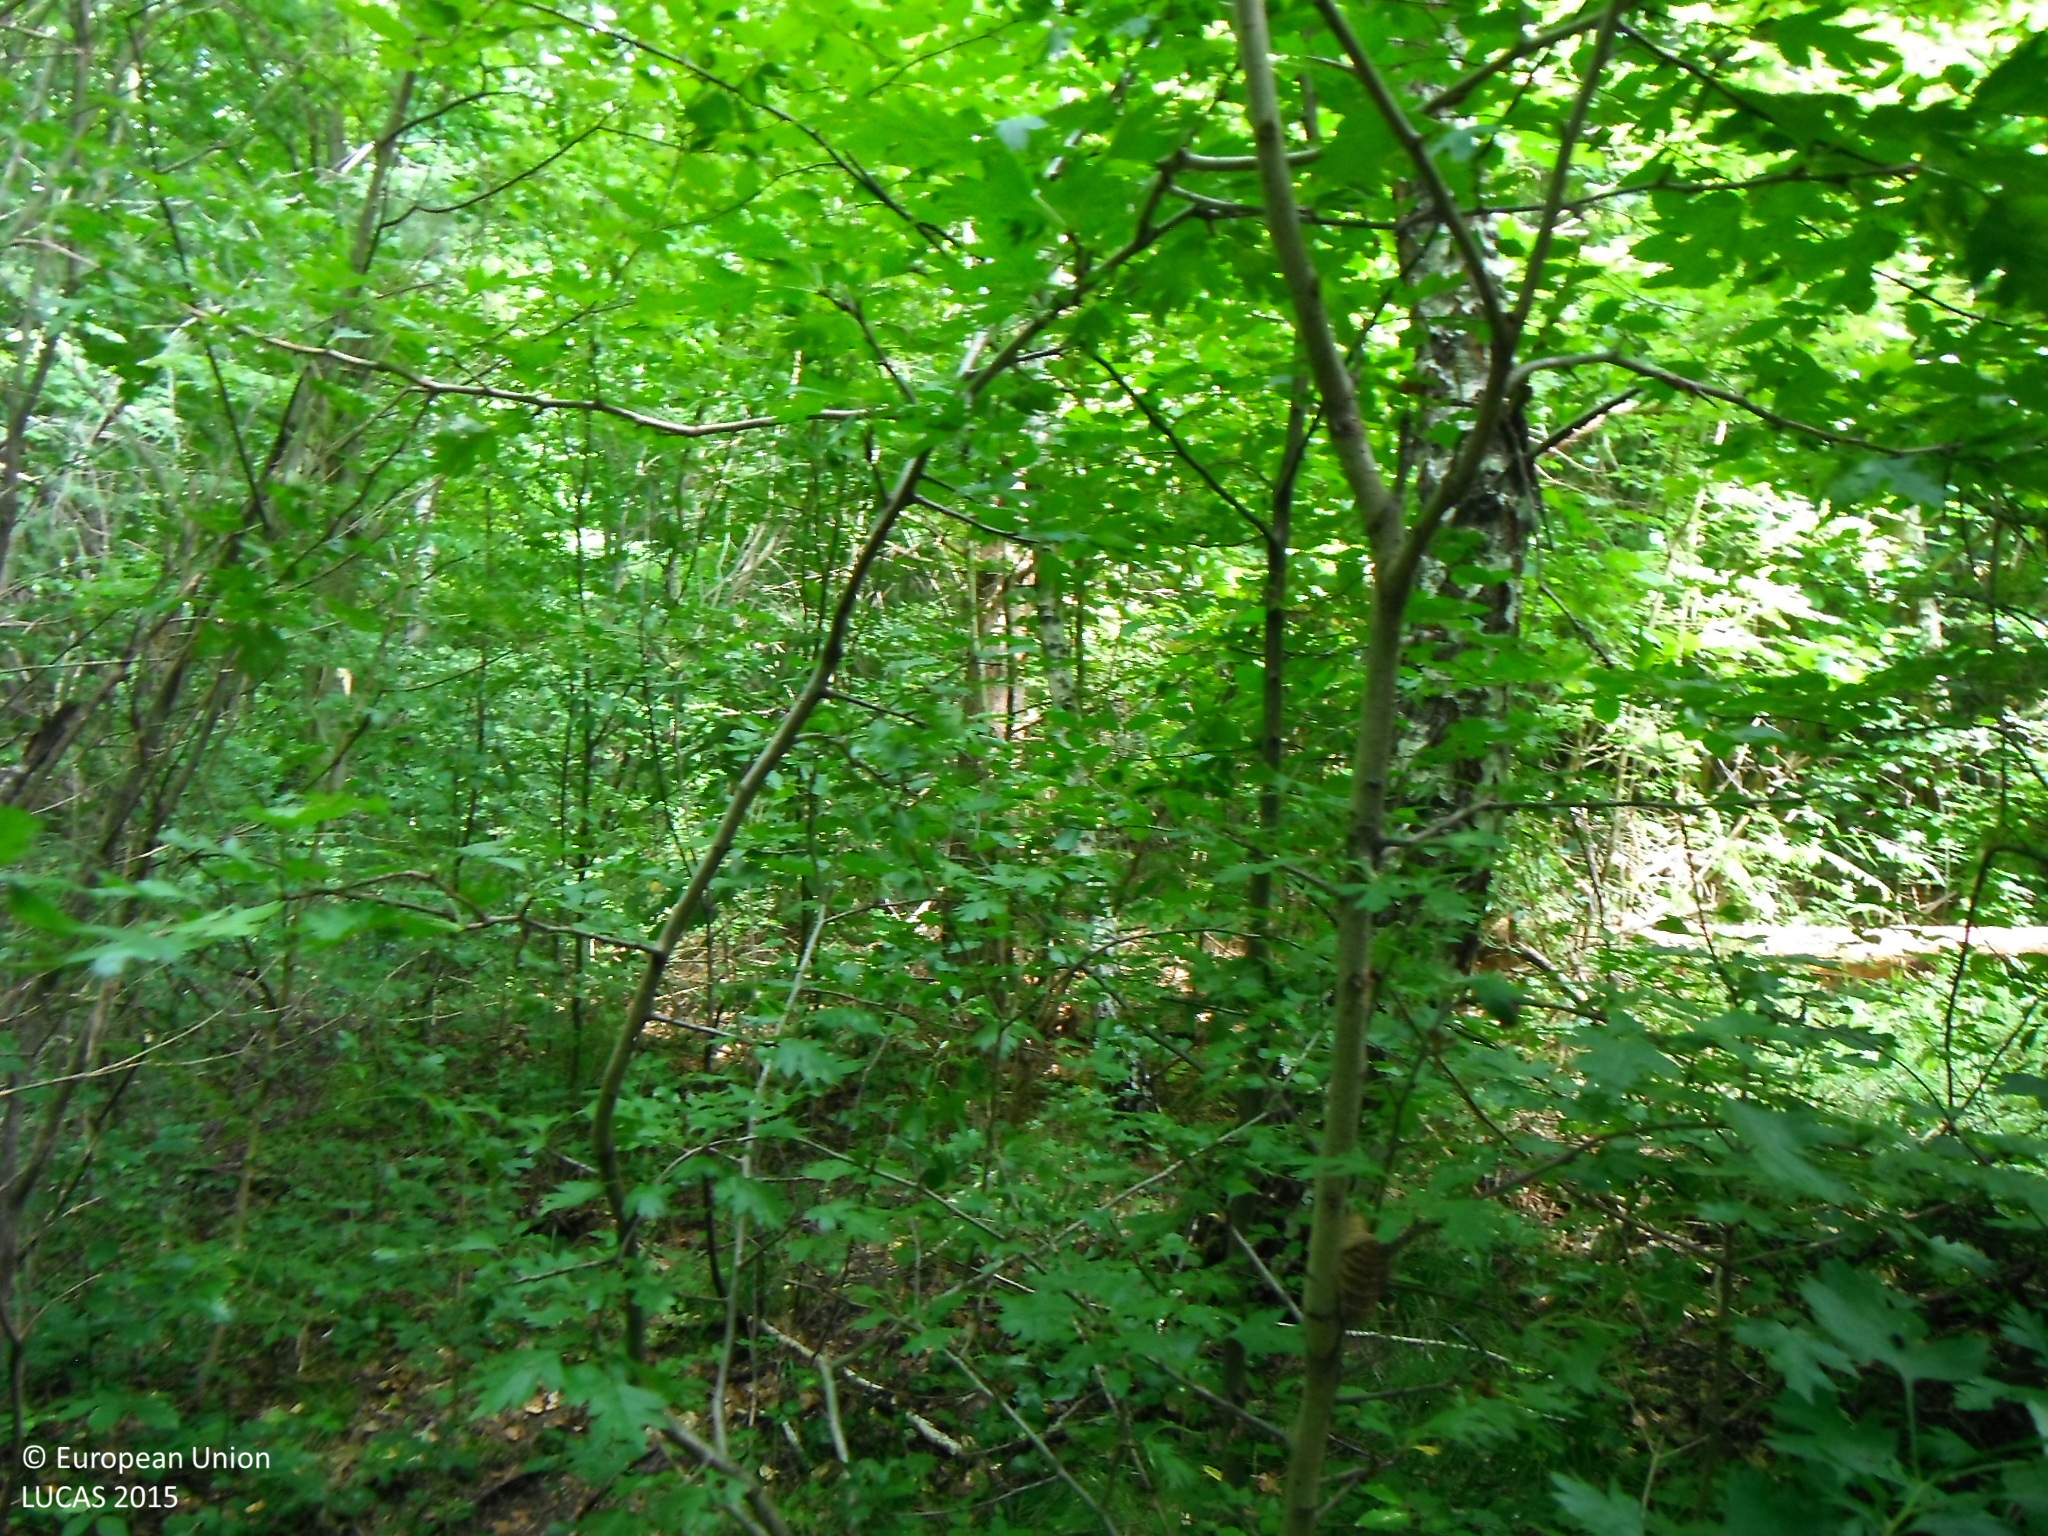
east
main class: Woodland
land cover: Broadleaved woodland
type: mesophytic deciduous forest
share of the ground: > 75 %
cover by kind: broadleaved forest trees 90 %, coniferous forest trees 10 %
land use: Forestry
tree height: > 5 m
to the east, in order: Broadleaved woodland; Ditches and canals; Broadleaved woodland; Grassland without tree/shrub cover; Broadleaved woodland; Grassland without tree/shrub cover
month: July
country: SK
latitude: 49.1628
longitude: 22.0284
